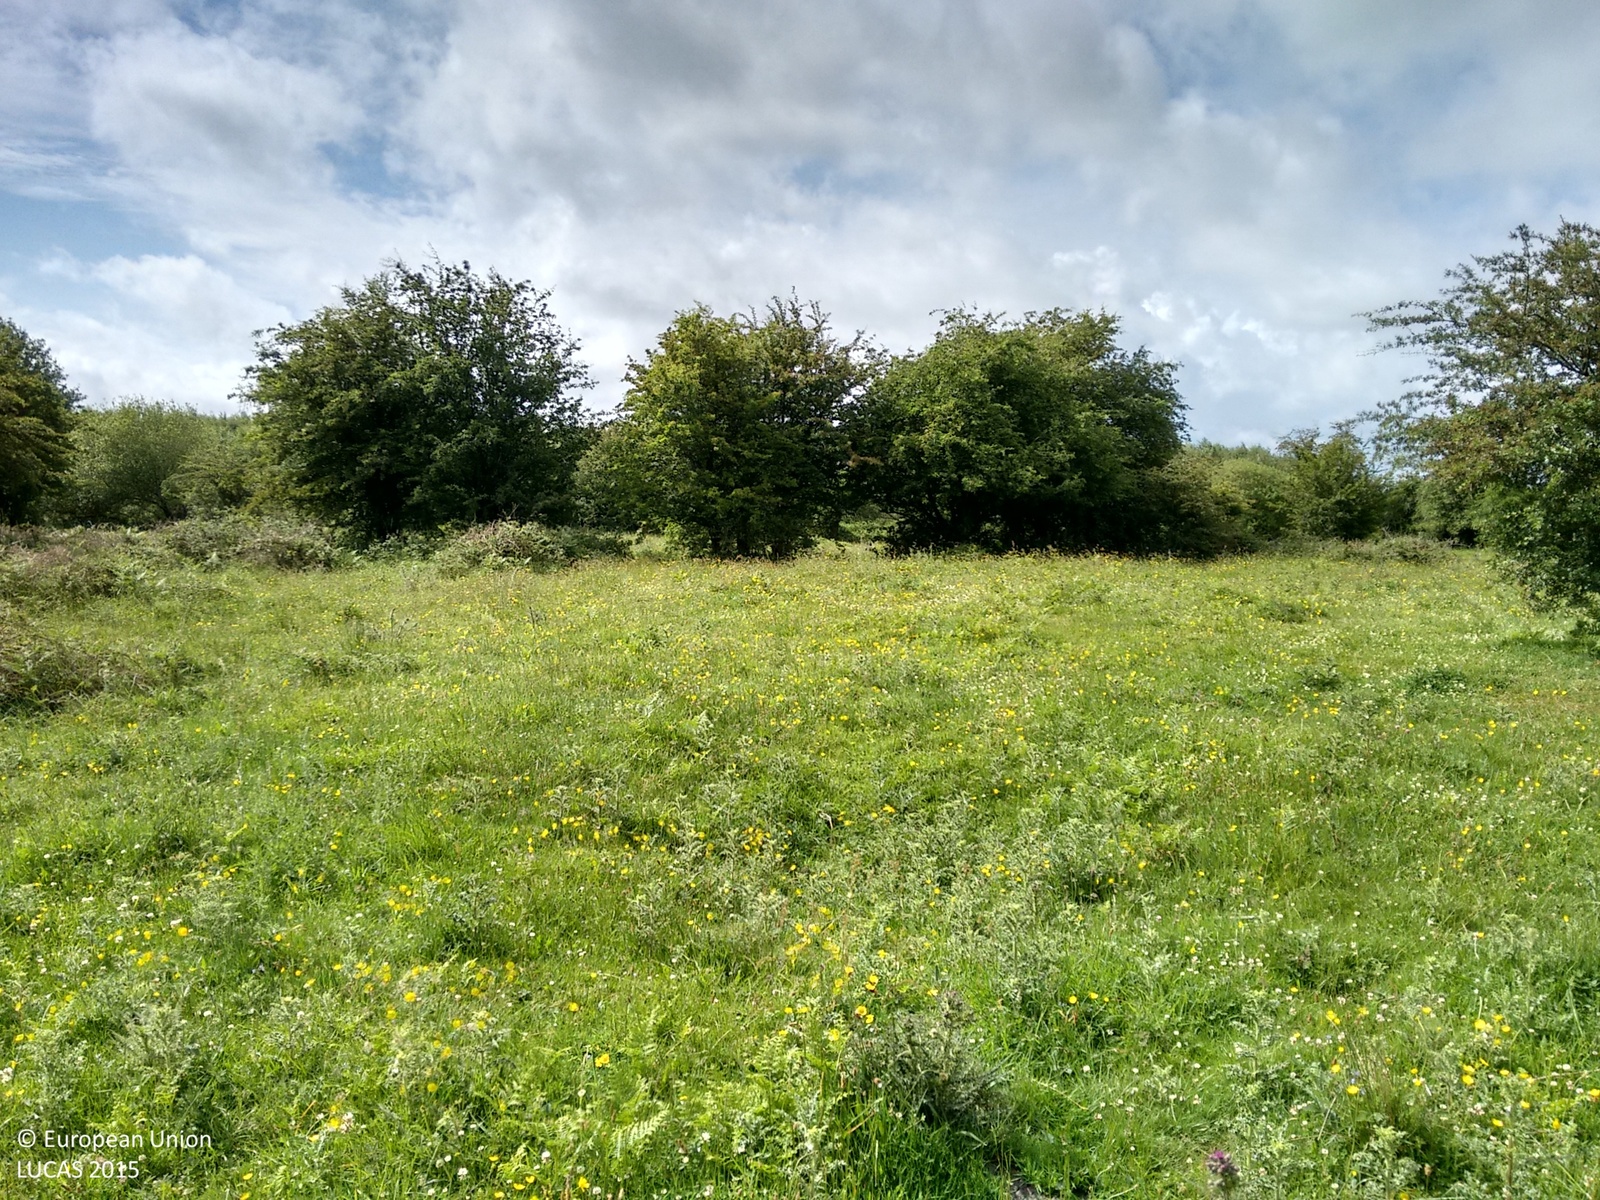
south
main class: Grassland
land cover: Grassland without tree/shrub cover
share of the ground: > 75 %
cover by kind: herbaceous plants 95 %, shrubs 5 %
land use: Agriculture (excluding fallow land and kitchen gardens)
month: June
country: IE
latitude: 53.6474
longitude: -6.8222
